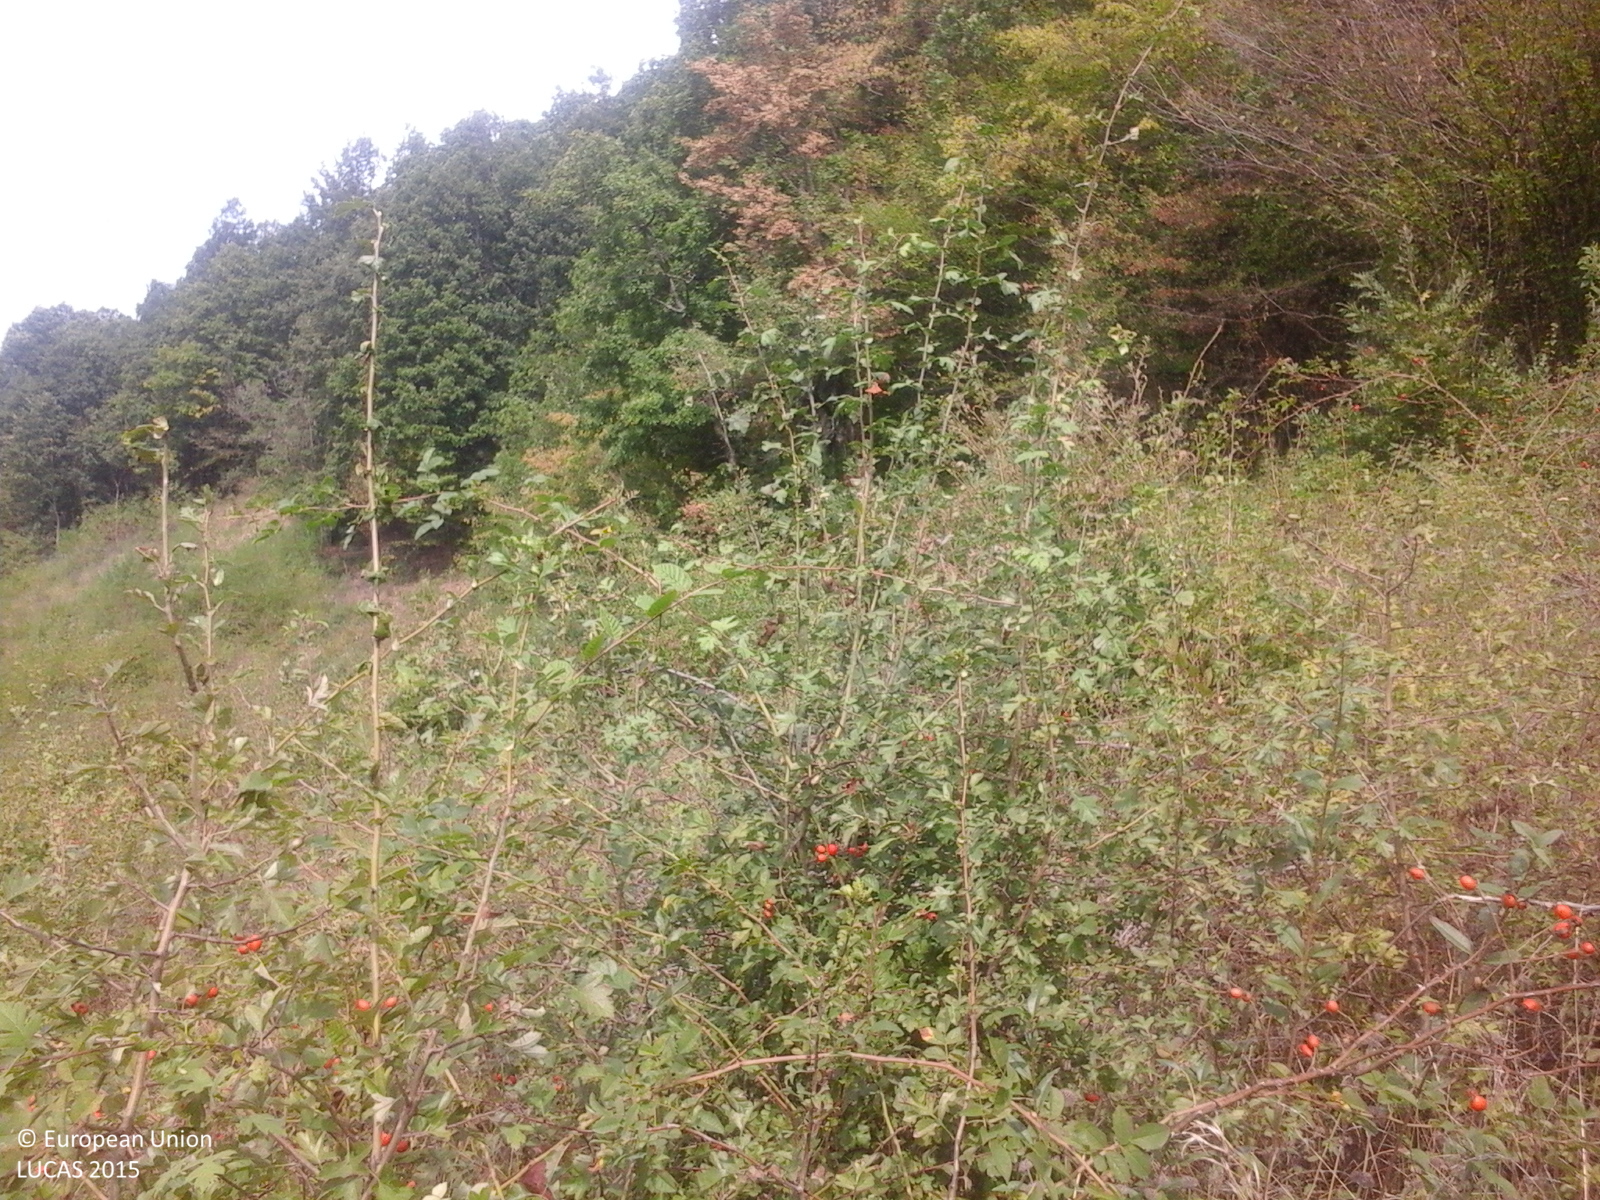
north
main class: Shrubland
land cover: Shrubland with sparse tree cover
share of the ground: > 75 %
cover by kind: shrubs 95 %, broadleaved forest trees 5 %
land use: Forestry
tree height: < 5 m
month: September
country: RO
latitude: 47.1832
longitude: 23.6805
